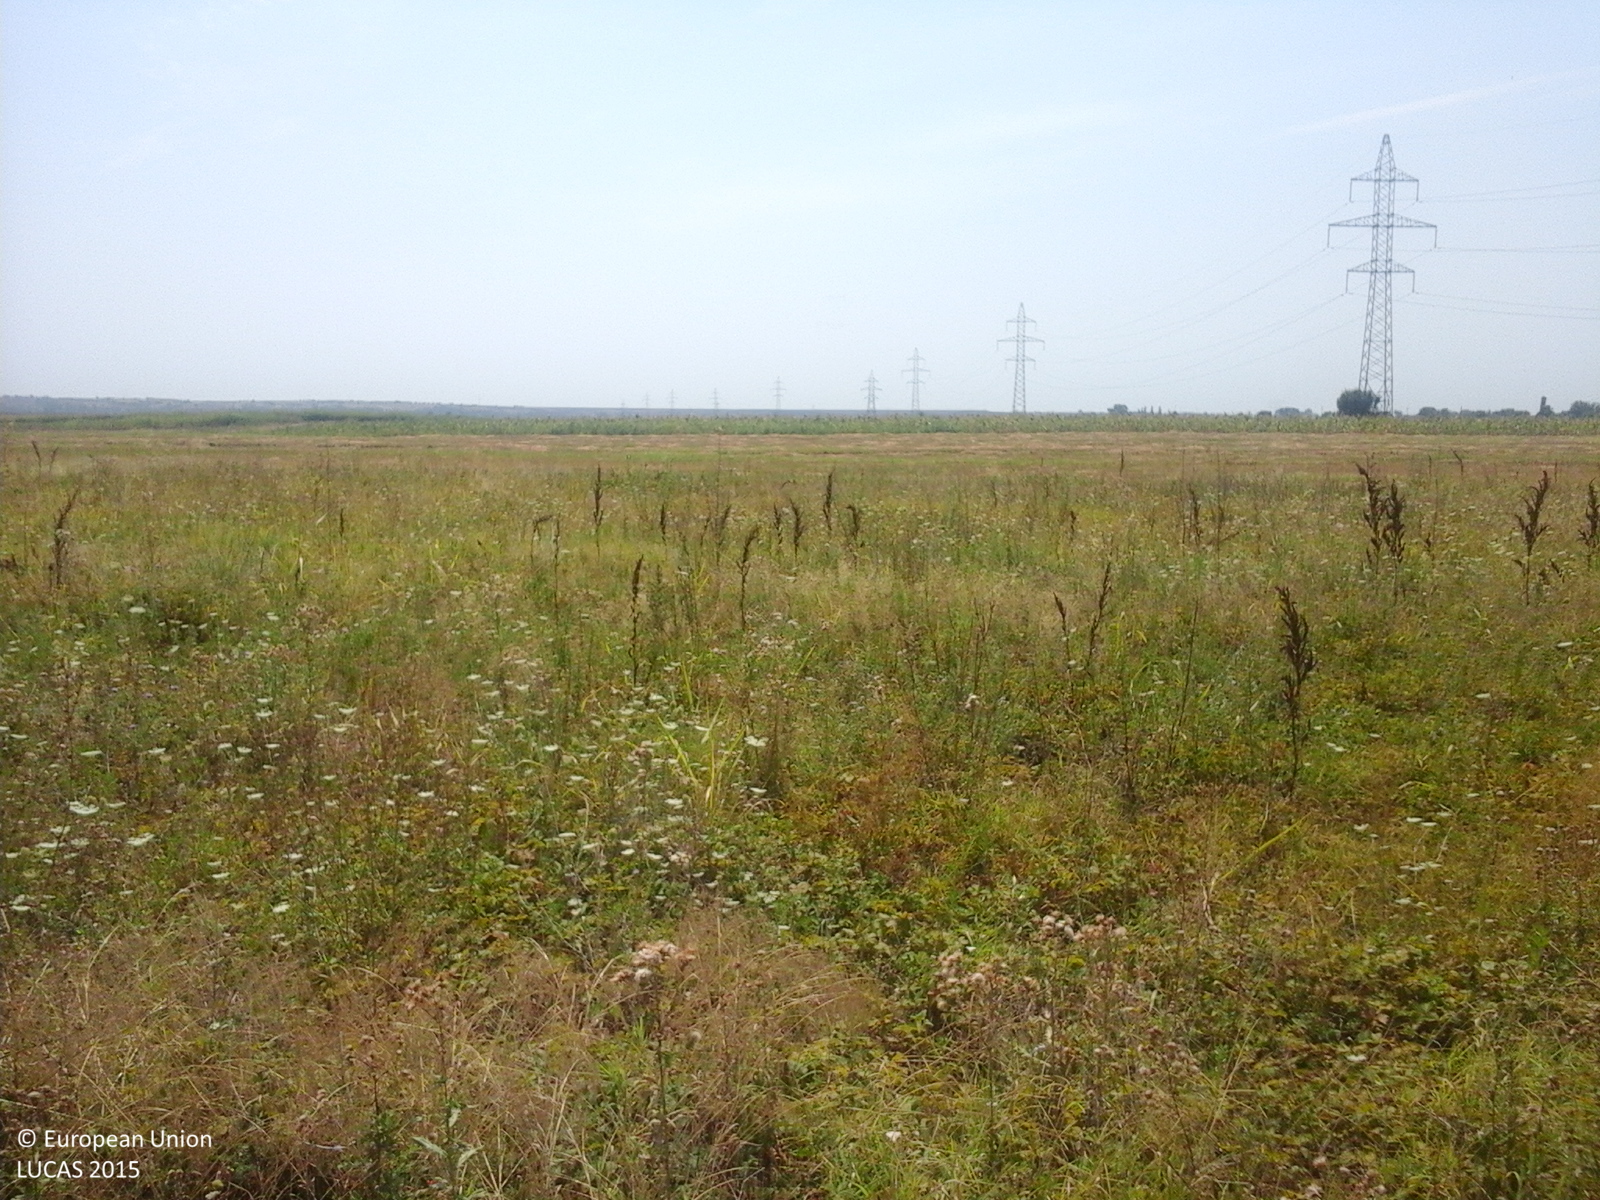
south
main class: Grassland
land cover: Spontaneously vegetated surfaces
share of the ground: > 75 %
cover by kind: herbaceous plants 100 %
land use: Fallow land
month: August
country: RO
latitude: 44.2672
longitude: 22.9332
